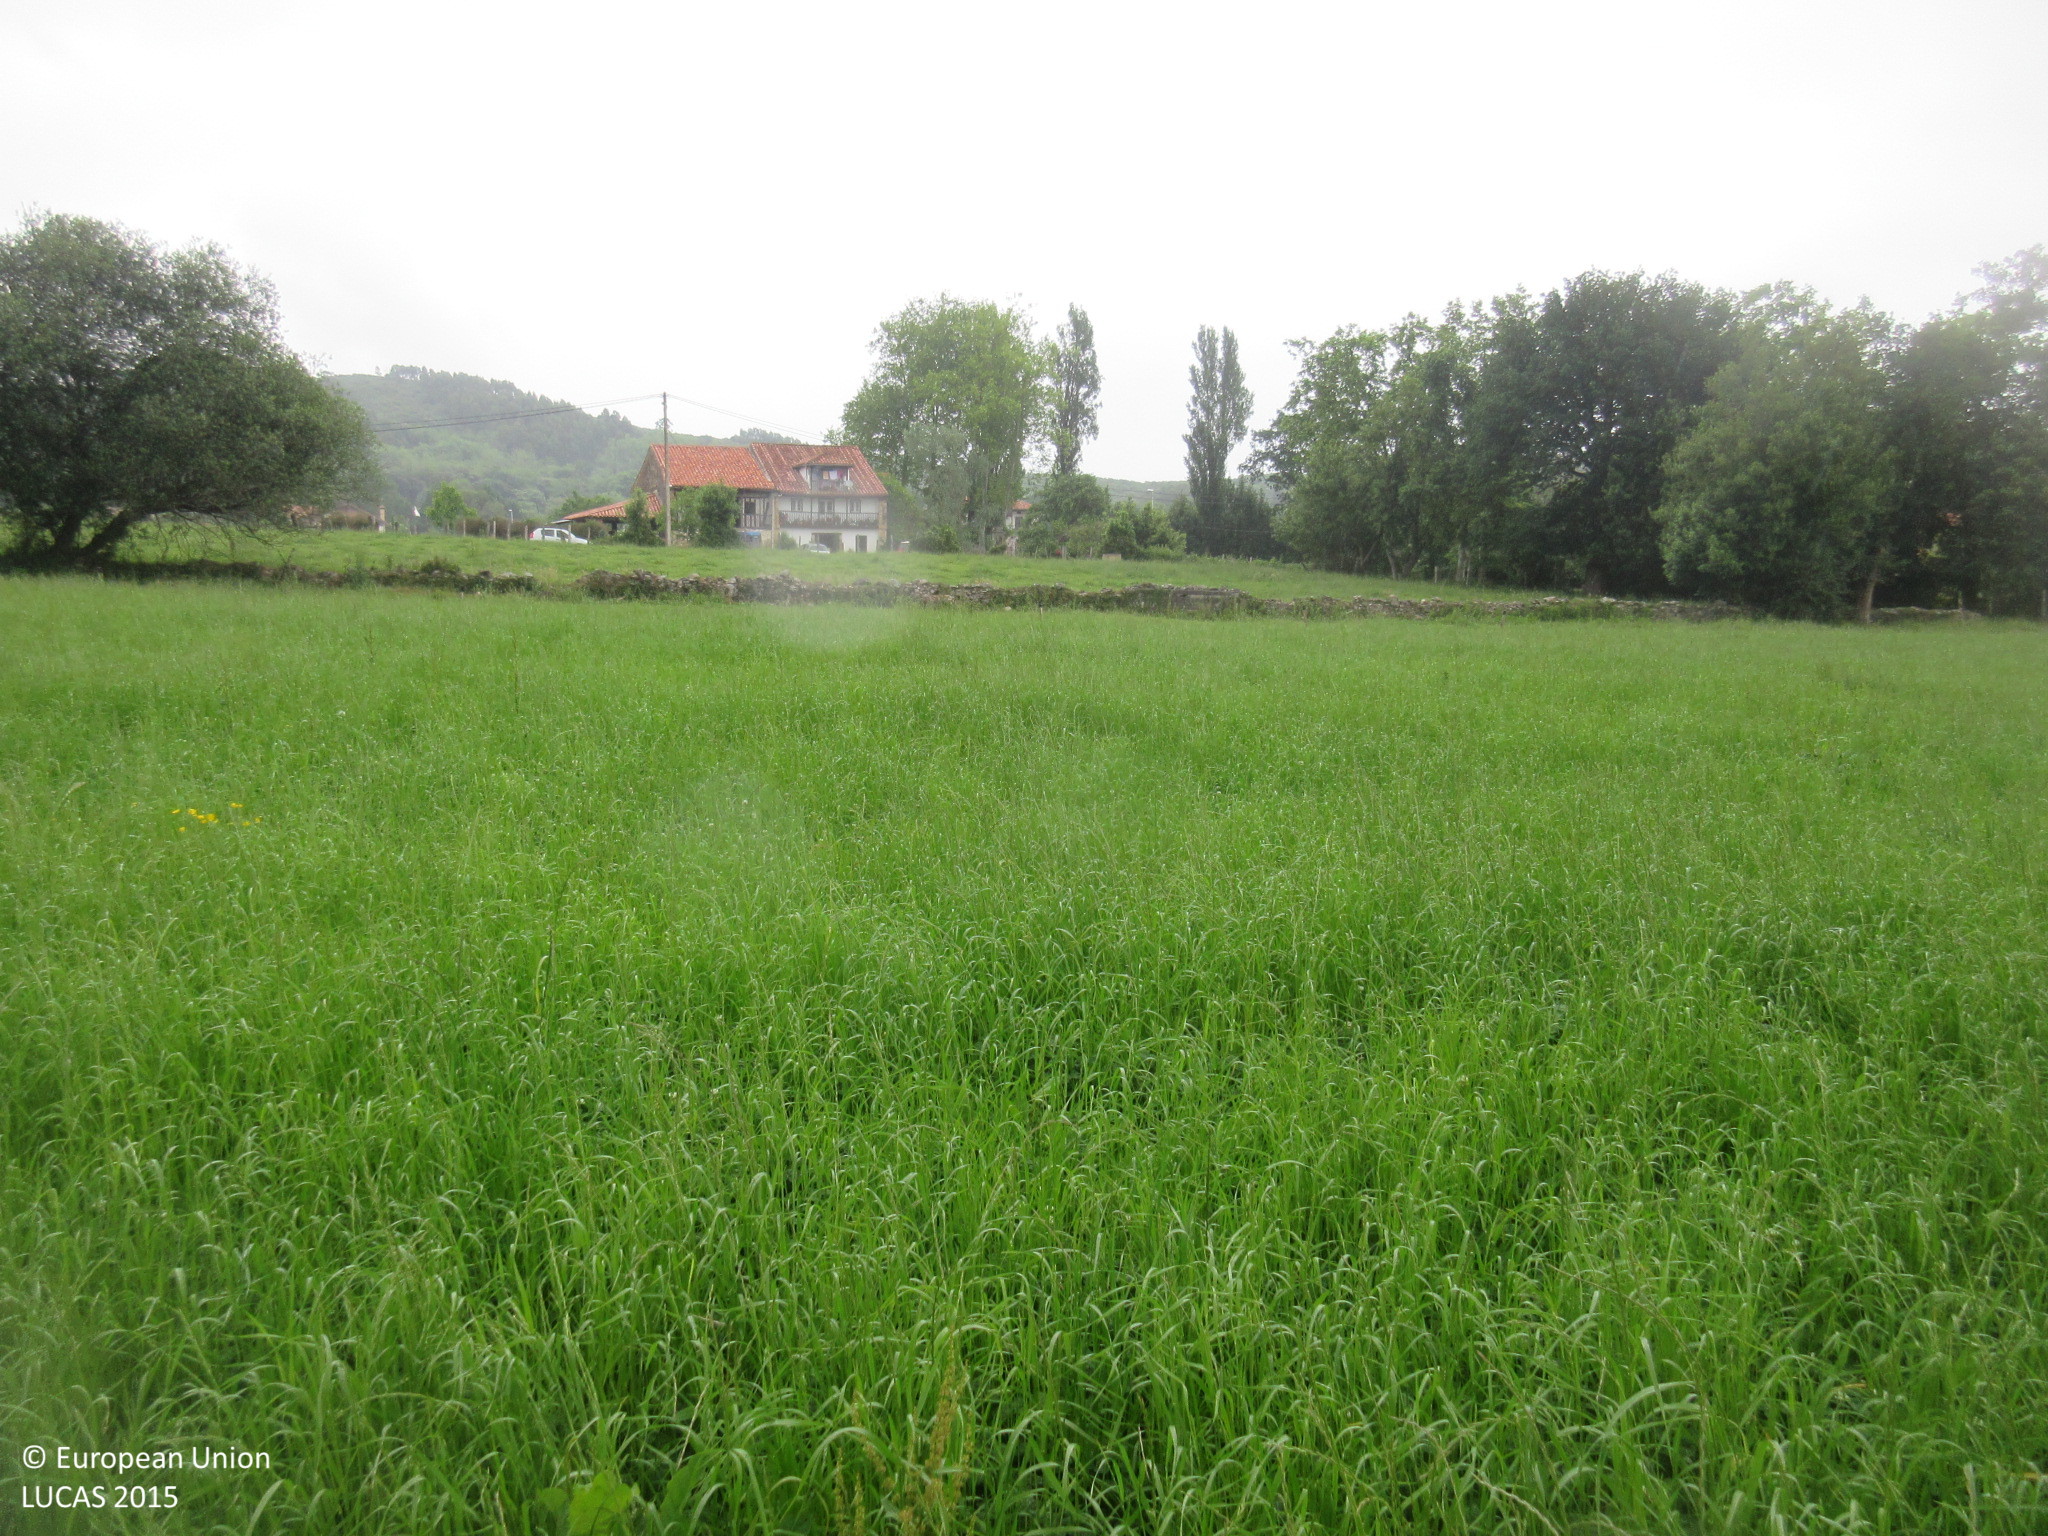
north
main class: Cropland
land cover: Temporary grasslands
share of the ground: > 75 %
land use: Agriculture (excluding fallow land and kitchen gardens)
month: June
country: ES
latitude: 43.4422
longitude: -3.5245
